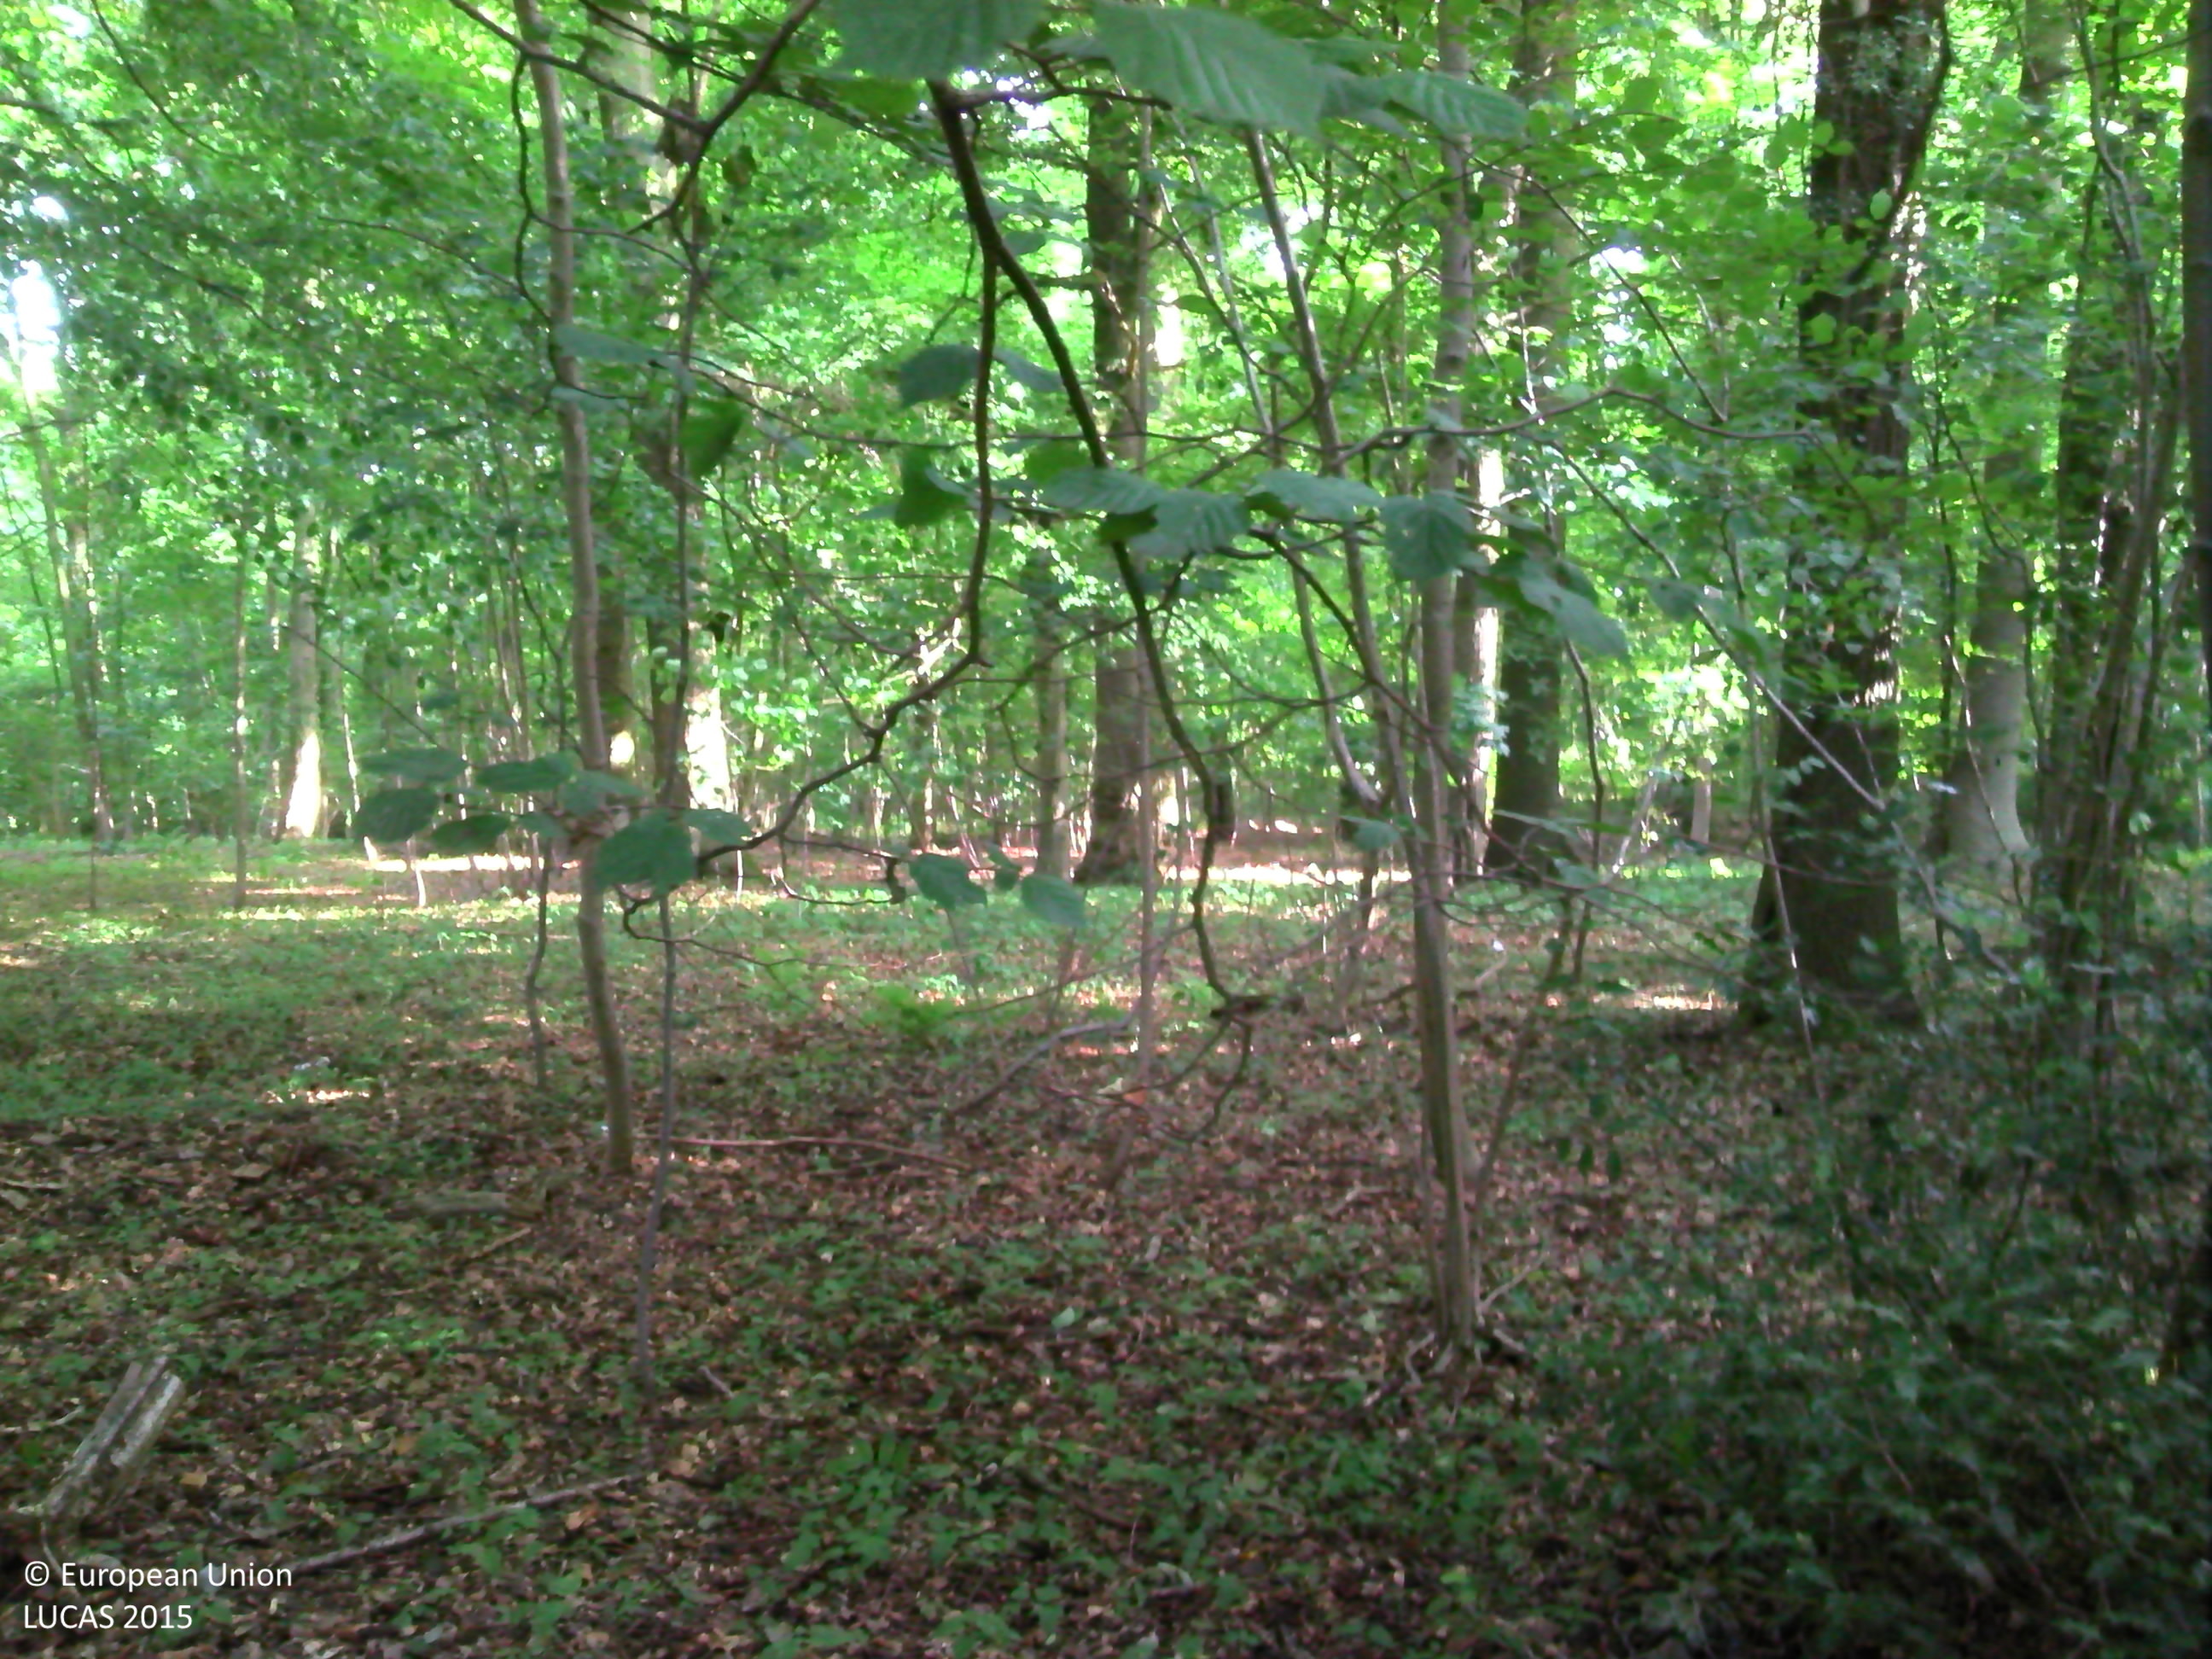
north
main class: Woodland
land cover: Broadleaved woodland
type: acidophilous oak and oak-birch forest
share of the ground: > 75 %
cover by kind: broadleaved forest trees 95 %, herbaceous plants 5 %
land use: Forestry
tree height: > 5 m
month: July
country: BE
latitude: 50.4804
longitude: 5.2203
